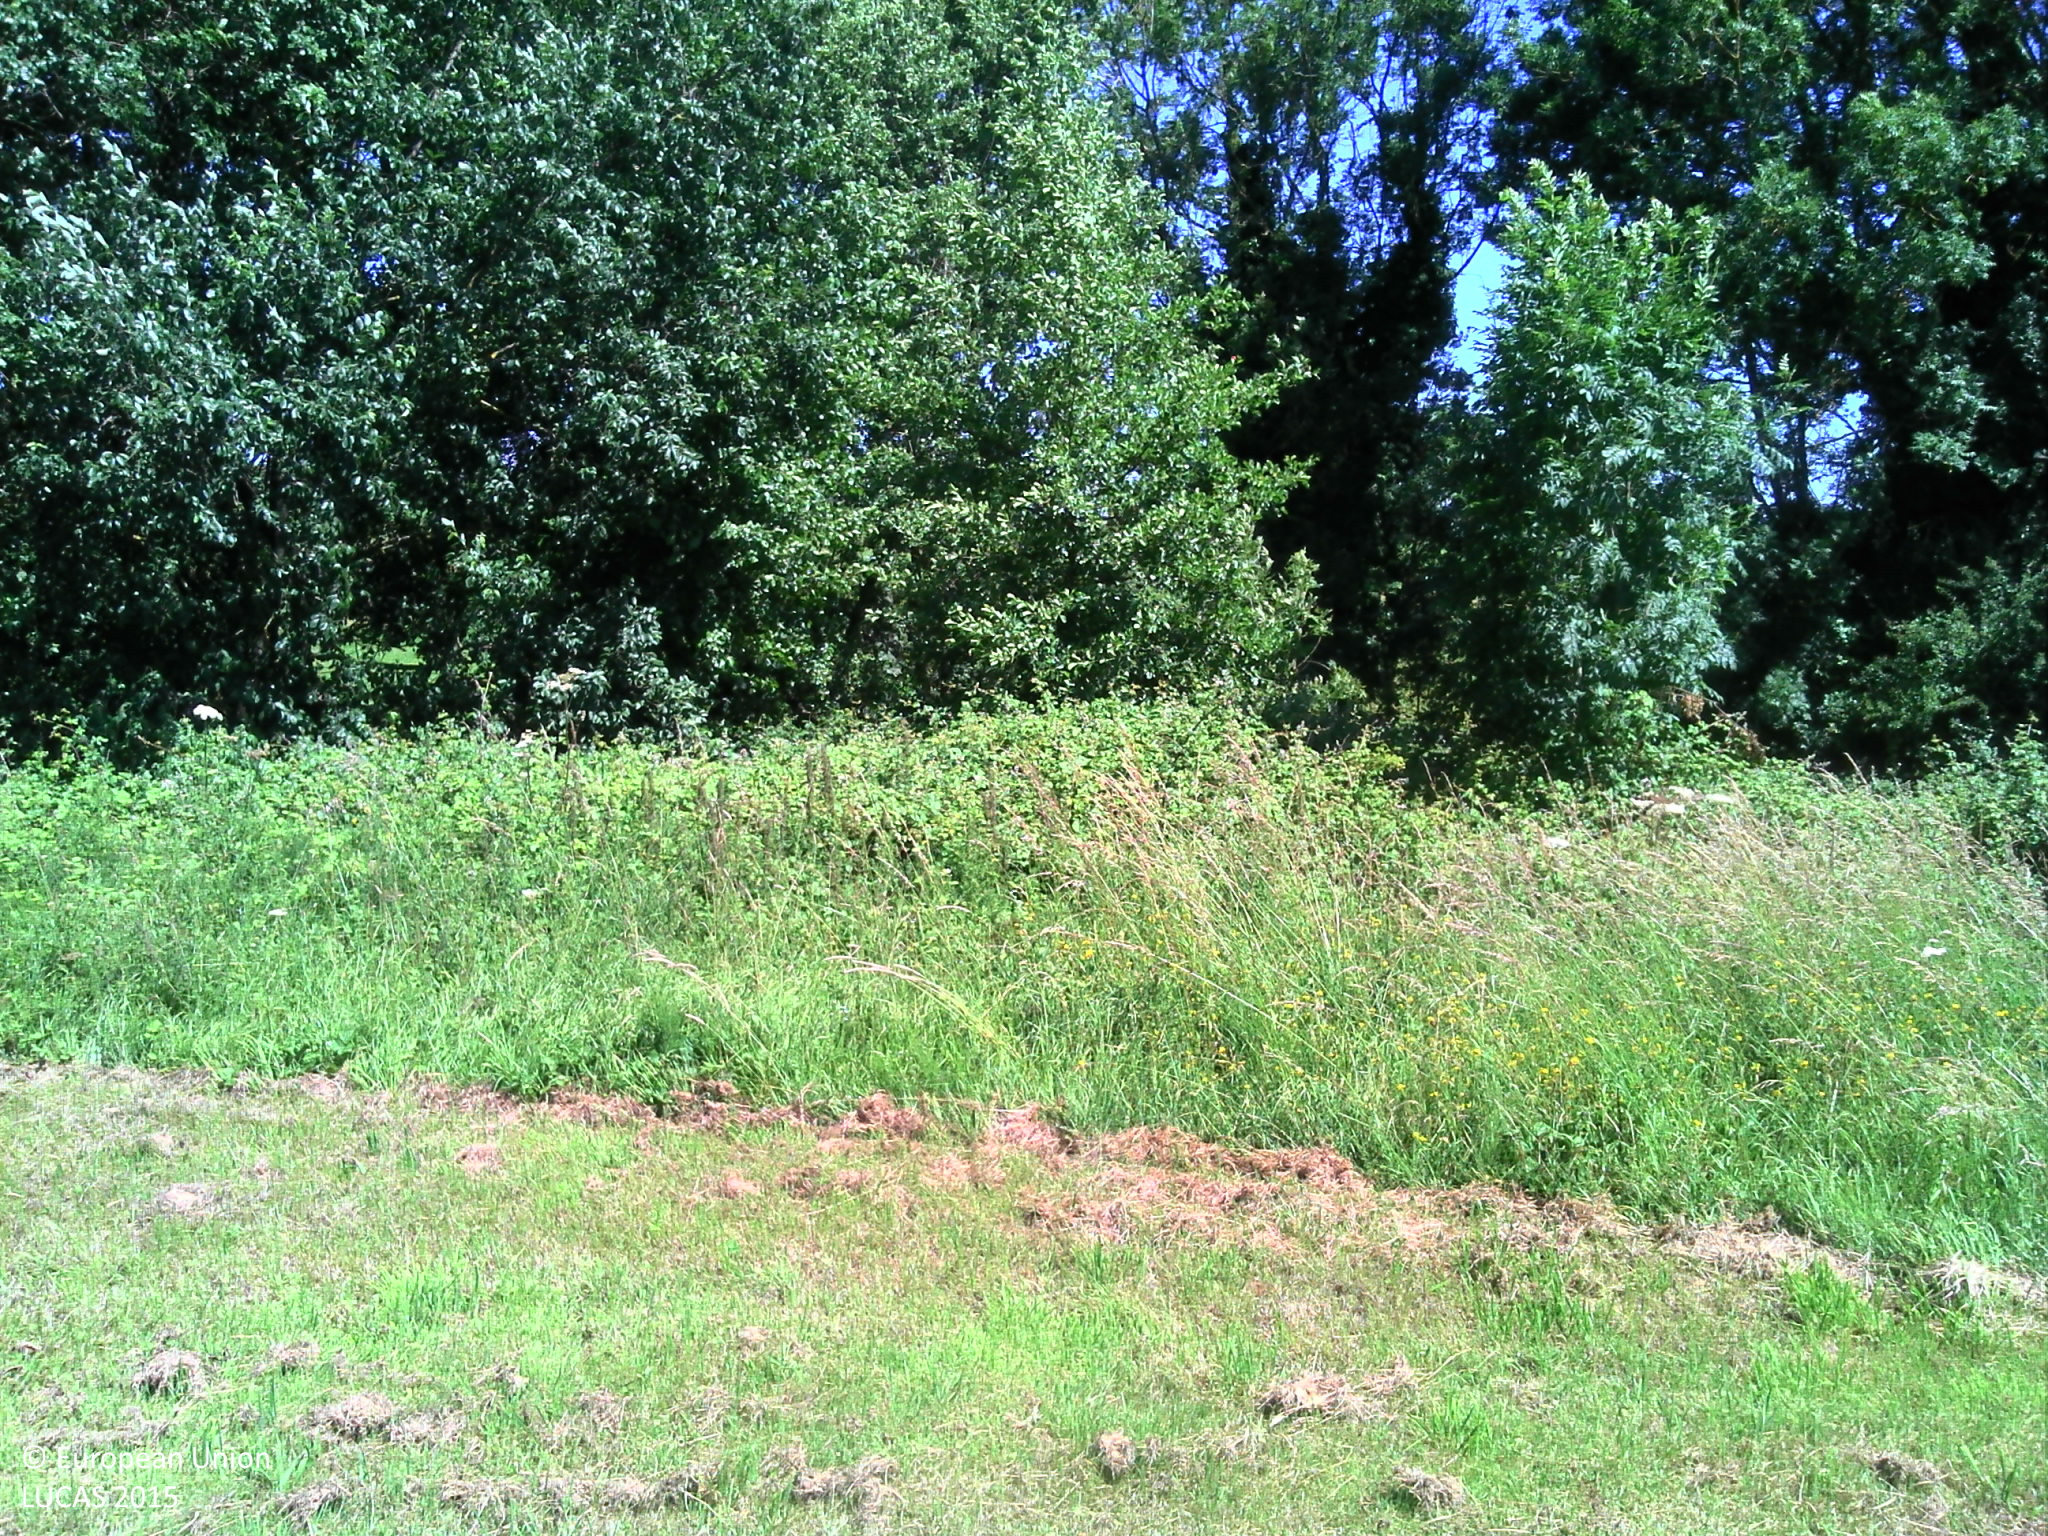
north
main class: Cropland
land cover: Barley
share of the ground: > 75 %
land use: Agriculture (excluding fallow land and kitchen gardens)
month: June
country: FR
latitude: 48.9952
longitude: 0.1438
